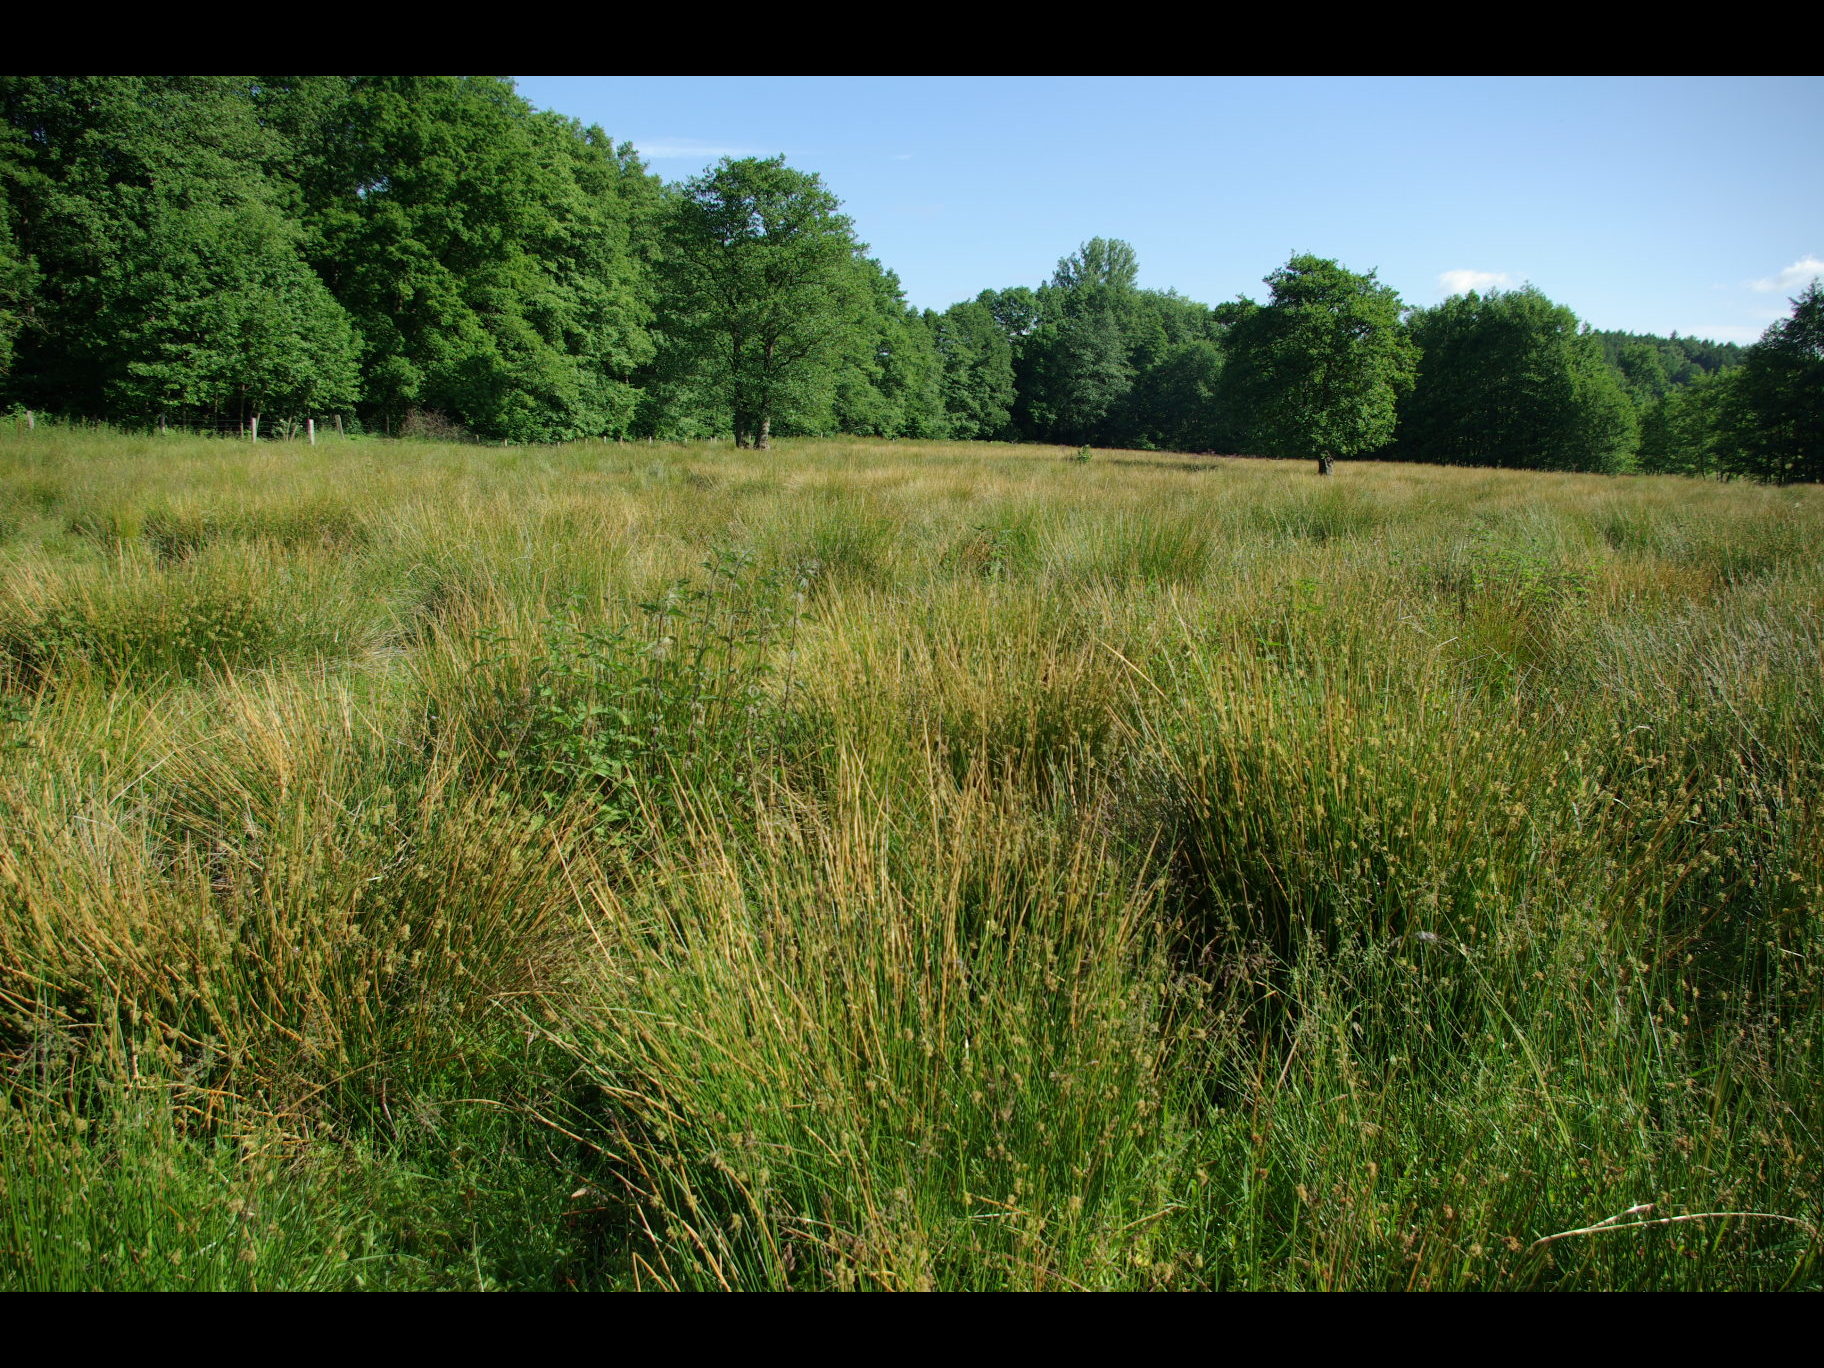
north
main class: Grassland
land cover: Grassland without tree/shrub cover
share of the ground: > 75 %
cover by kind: herbaceous plants 100 %
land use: Agriculture (excluding fallow land and kitchen gardens)
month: June
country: DE
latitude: 54.2645
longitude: 9.9233
